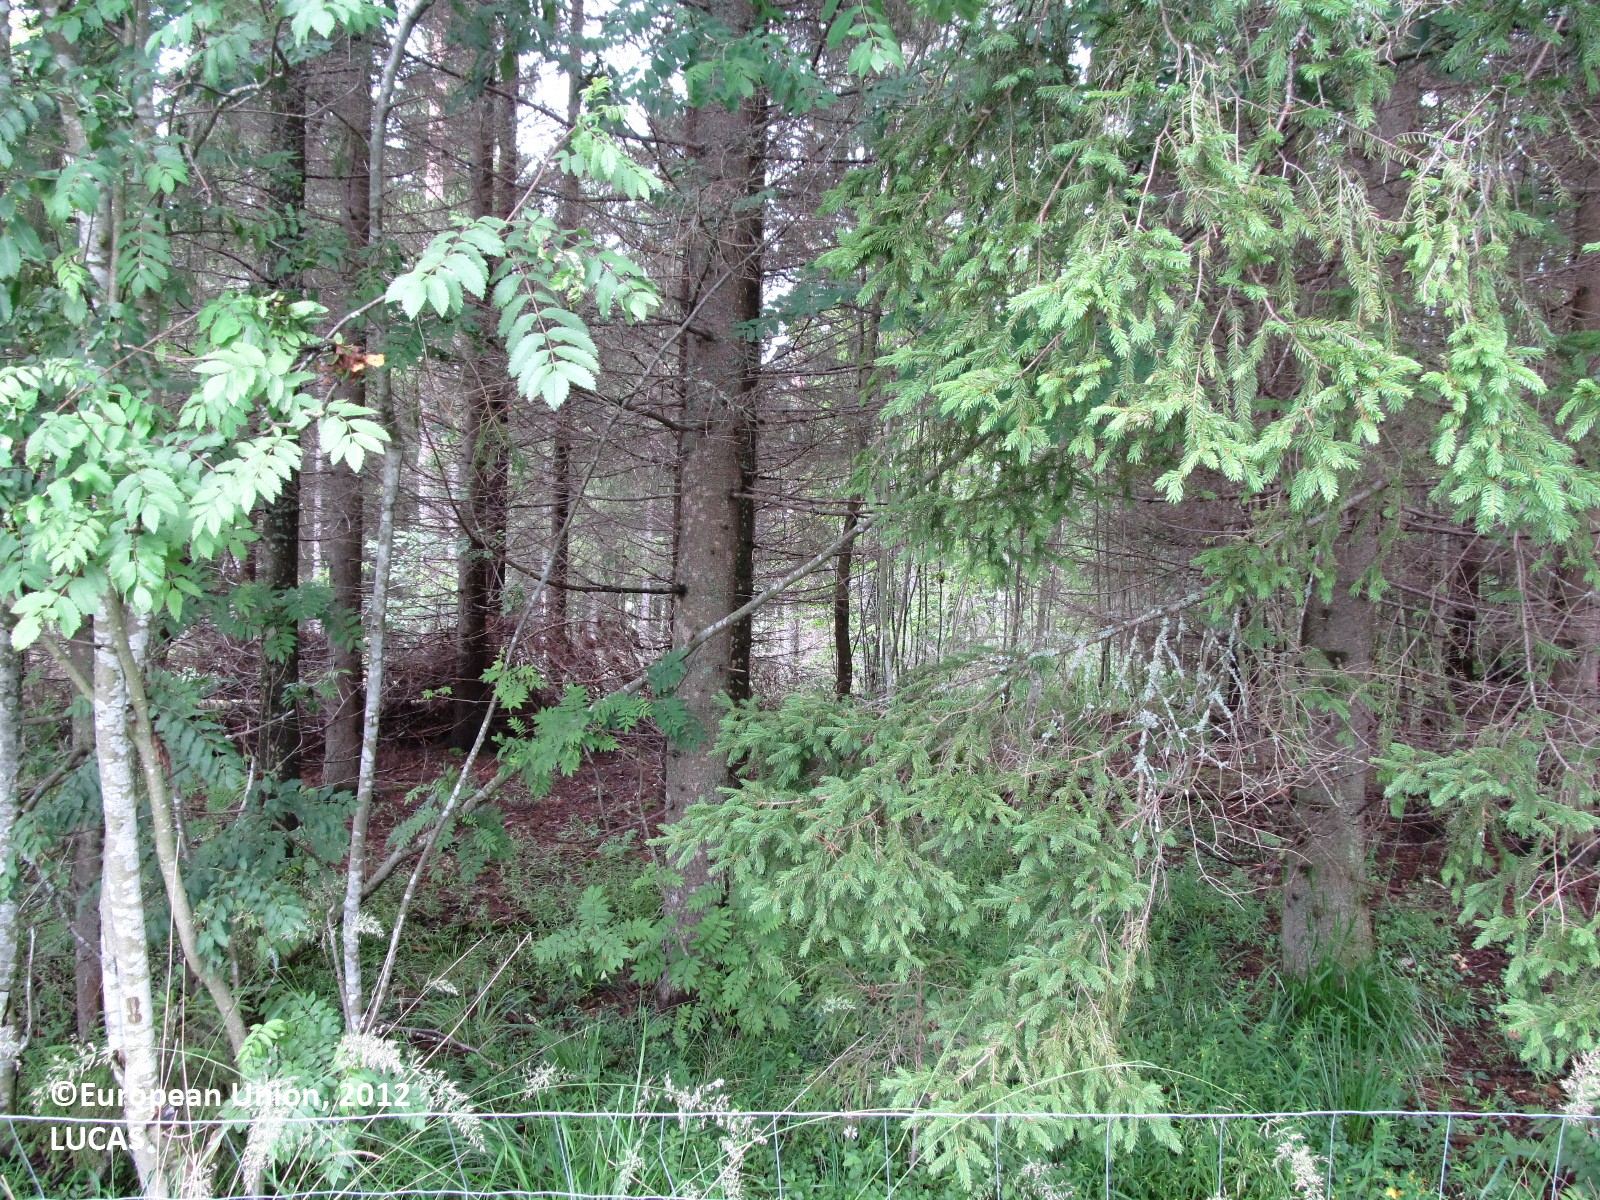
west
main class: Grassland
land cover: Grassland without tree/shrub cover
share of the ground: 25 - 50 %
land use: Forestry
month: July
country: FI
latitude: 61.8472
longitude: 29.0175
